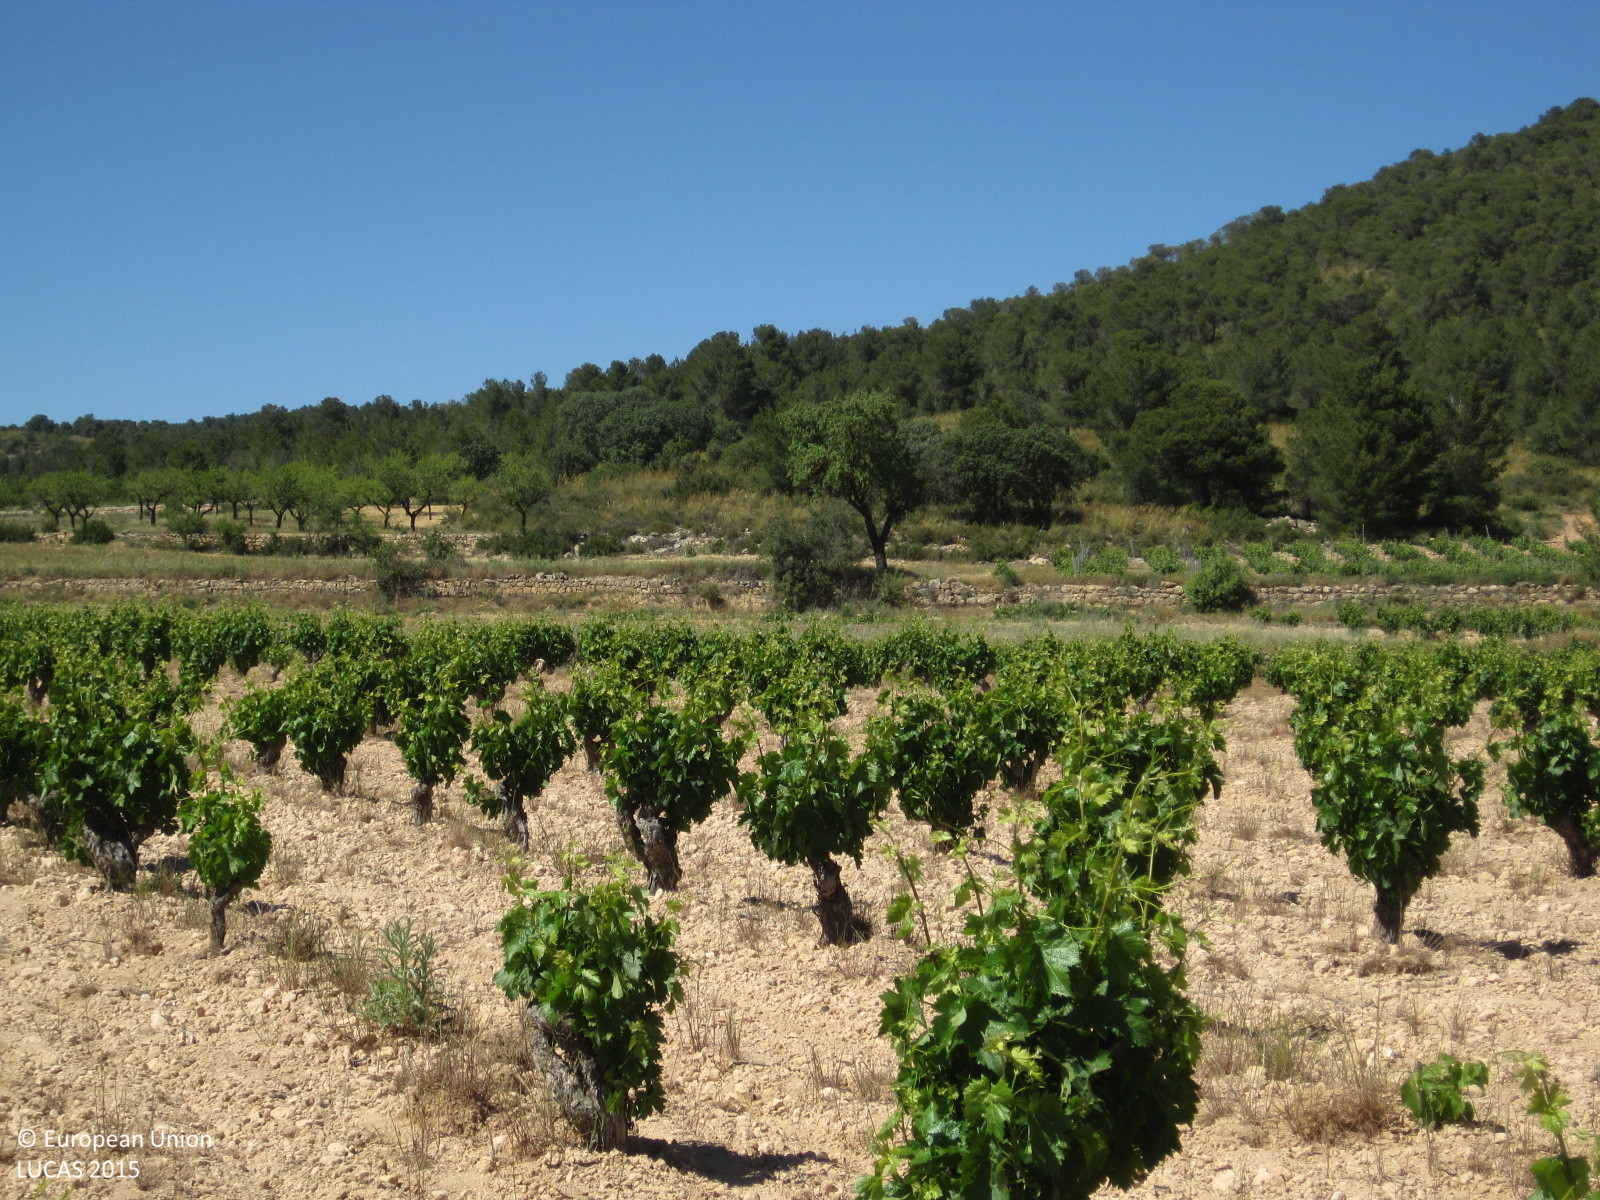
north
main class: Cropland
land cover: Vineyards
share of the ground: 10 - 25 %
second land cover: Spontaneously vegetated surfaces
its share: < 10 %
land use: Agriculture (excluding fallow land and kitchen gardens)
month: May
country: ES
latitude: 39.4172
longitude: -1.0929
